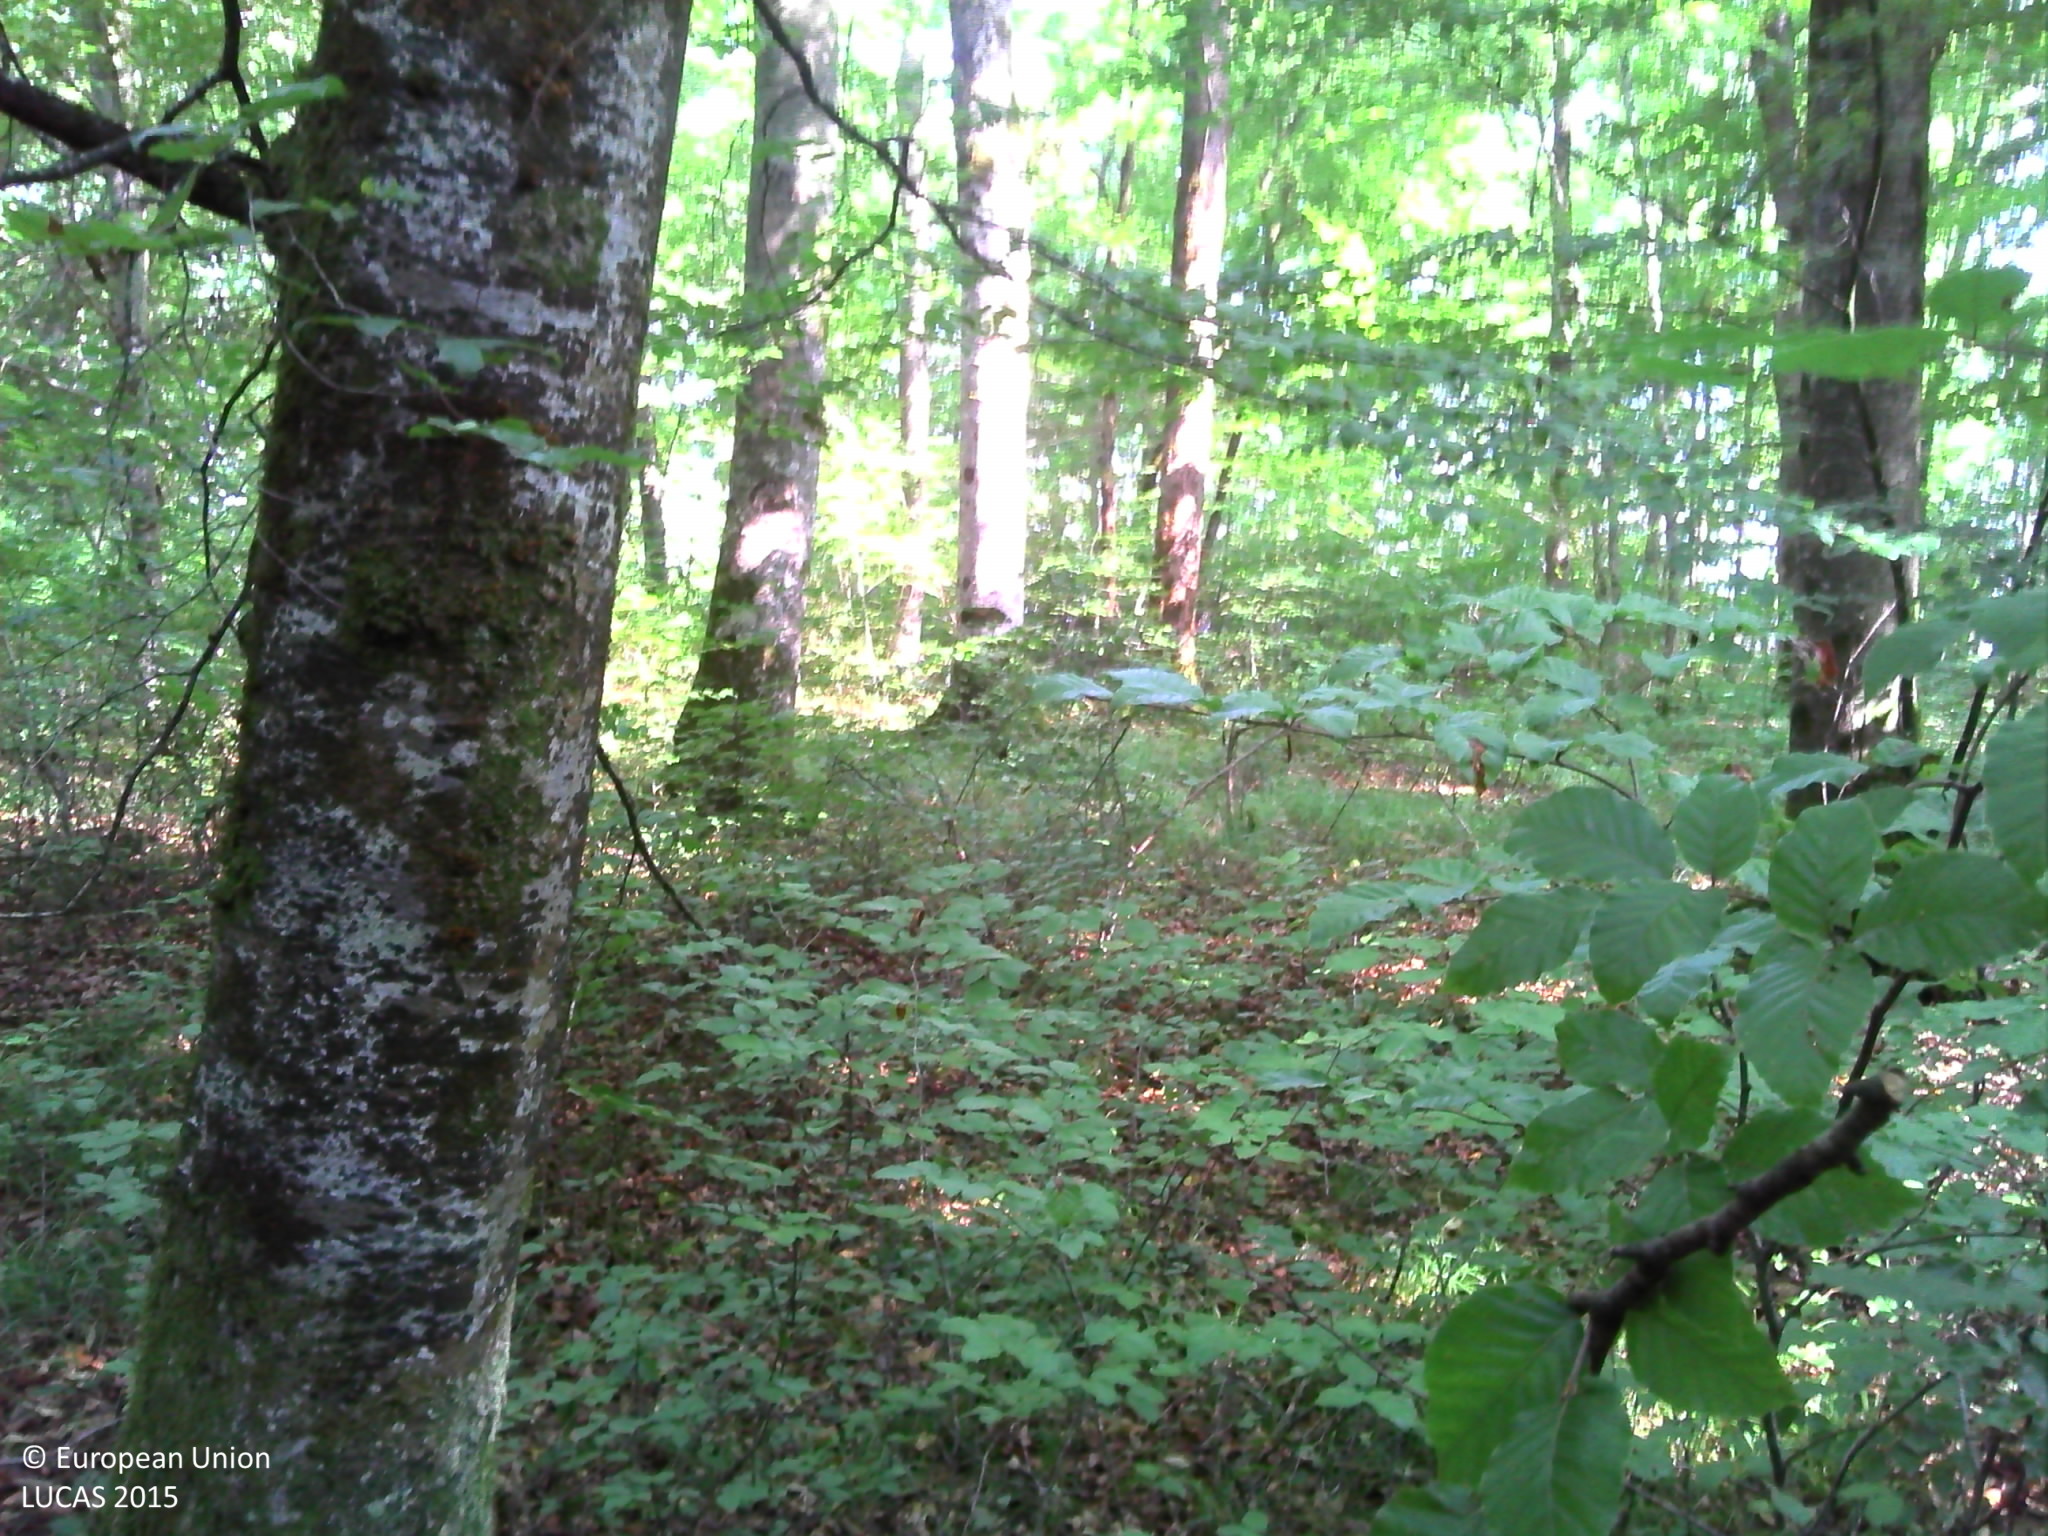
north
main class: Woodland
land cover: Broadleaved woodland
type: mesophytic deciduous forest
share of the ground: > 75 %
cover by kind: broadleaved forest trees 90 %, herbaceous plants 5 %, lichens and mosses 5 %
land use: Forestry
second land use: Amenities, museums, leisure
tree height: > 5 m
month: August
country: FR
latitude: 47.8638
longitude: 4.7454
